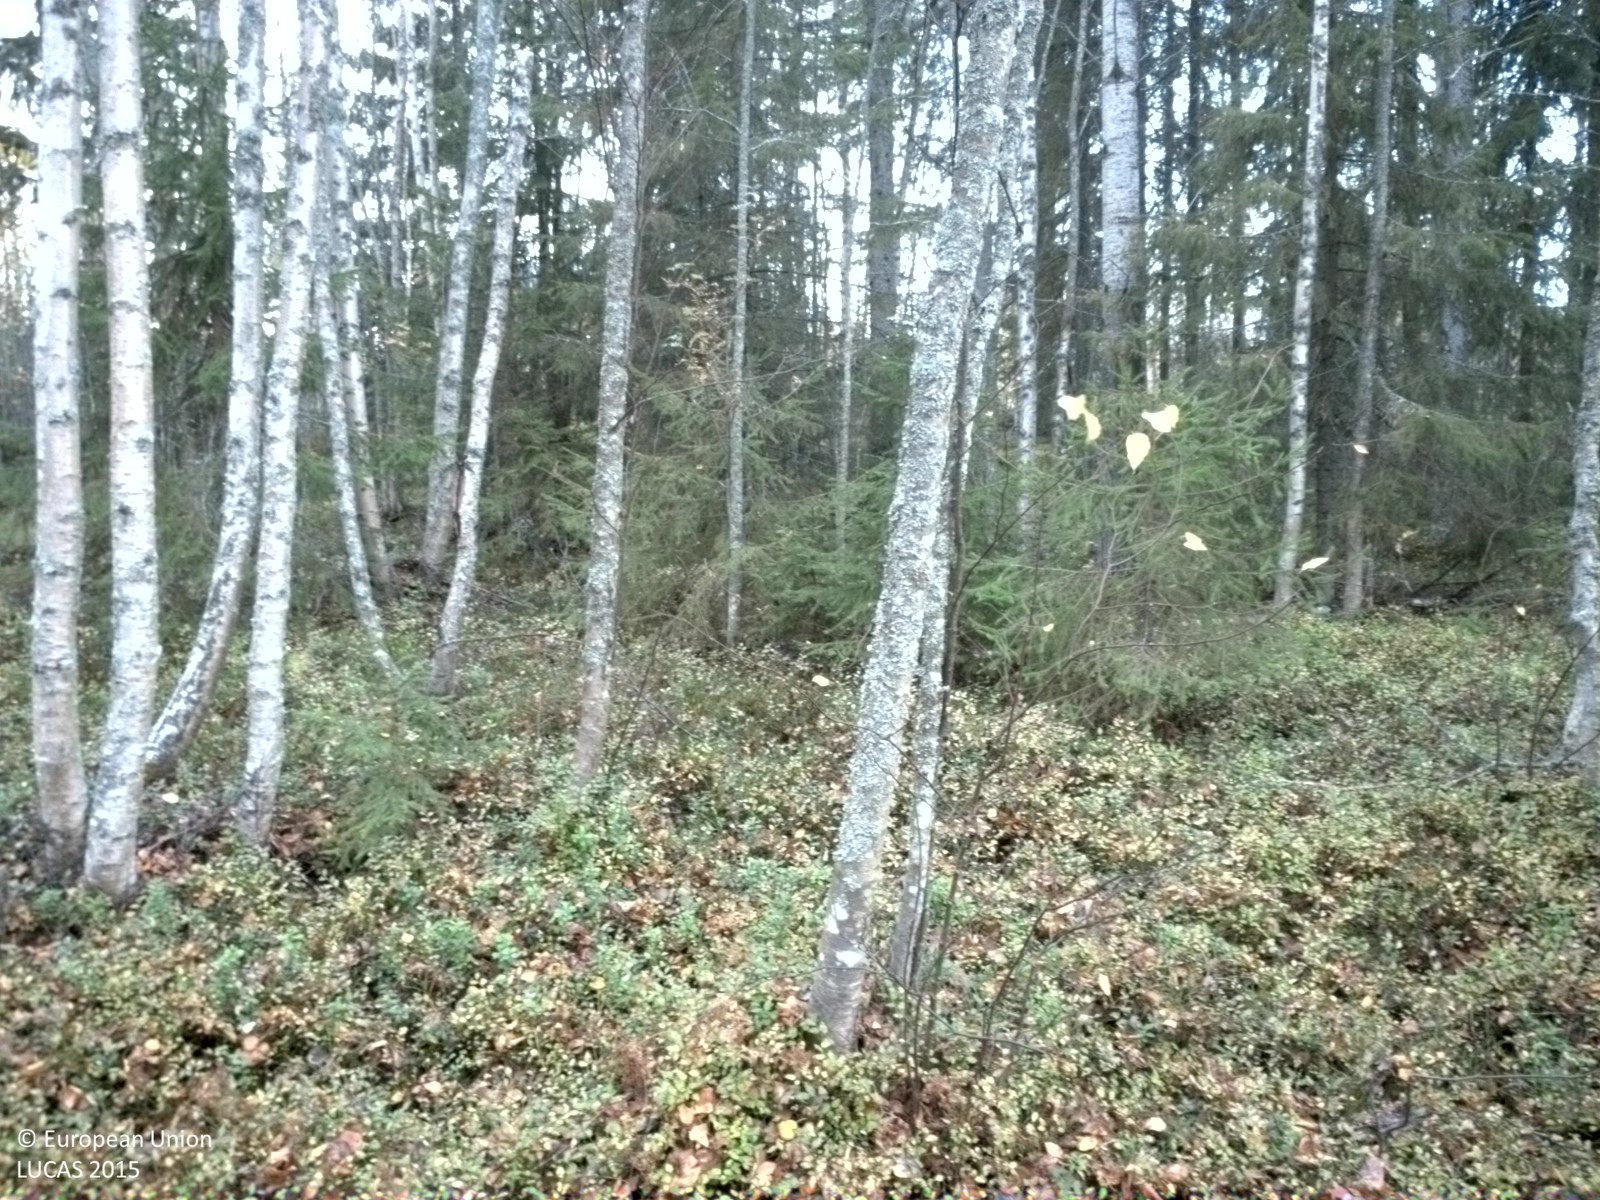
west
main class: Woodland
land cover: Spruce dominated mixed woodland
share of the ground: 25 - 50 %
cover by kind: shrubs 50 %, broadleaved forest trees 30 %, coniferous forest trees 20 %
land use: Forestry
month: October
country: SE
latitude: 65.6340
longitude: 21.9022
